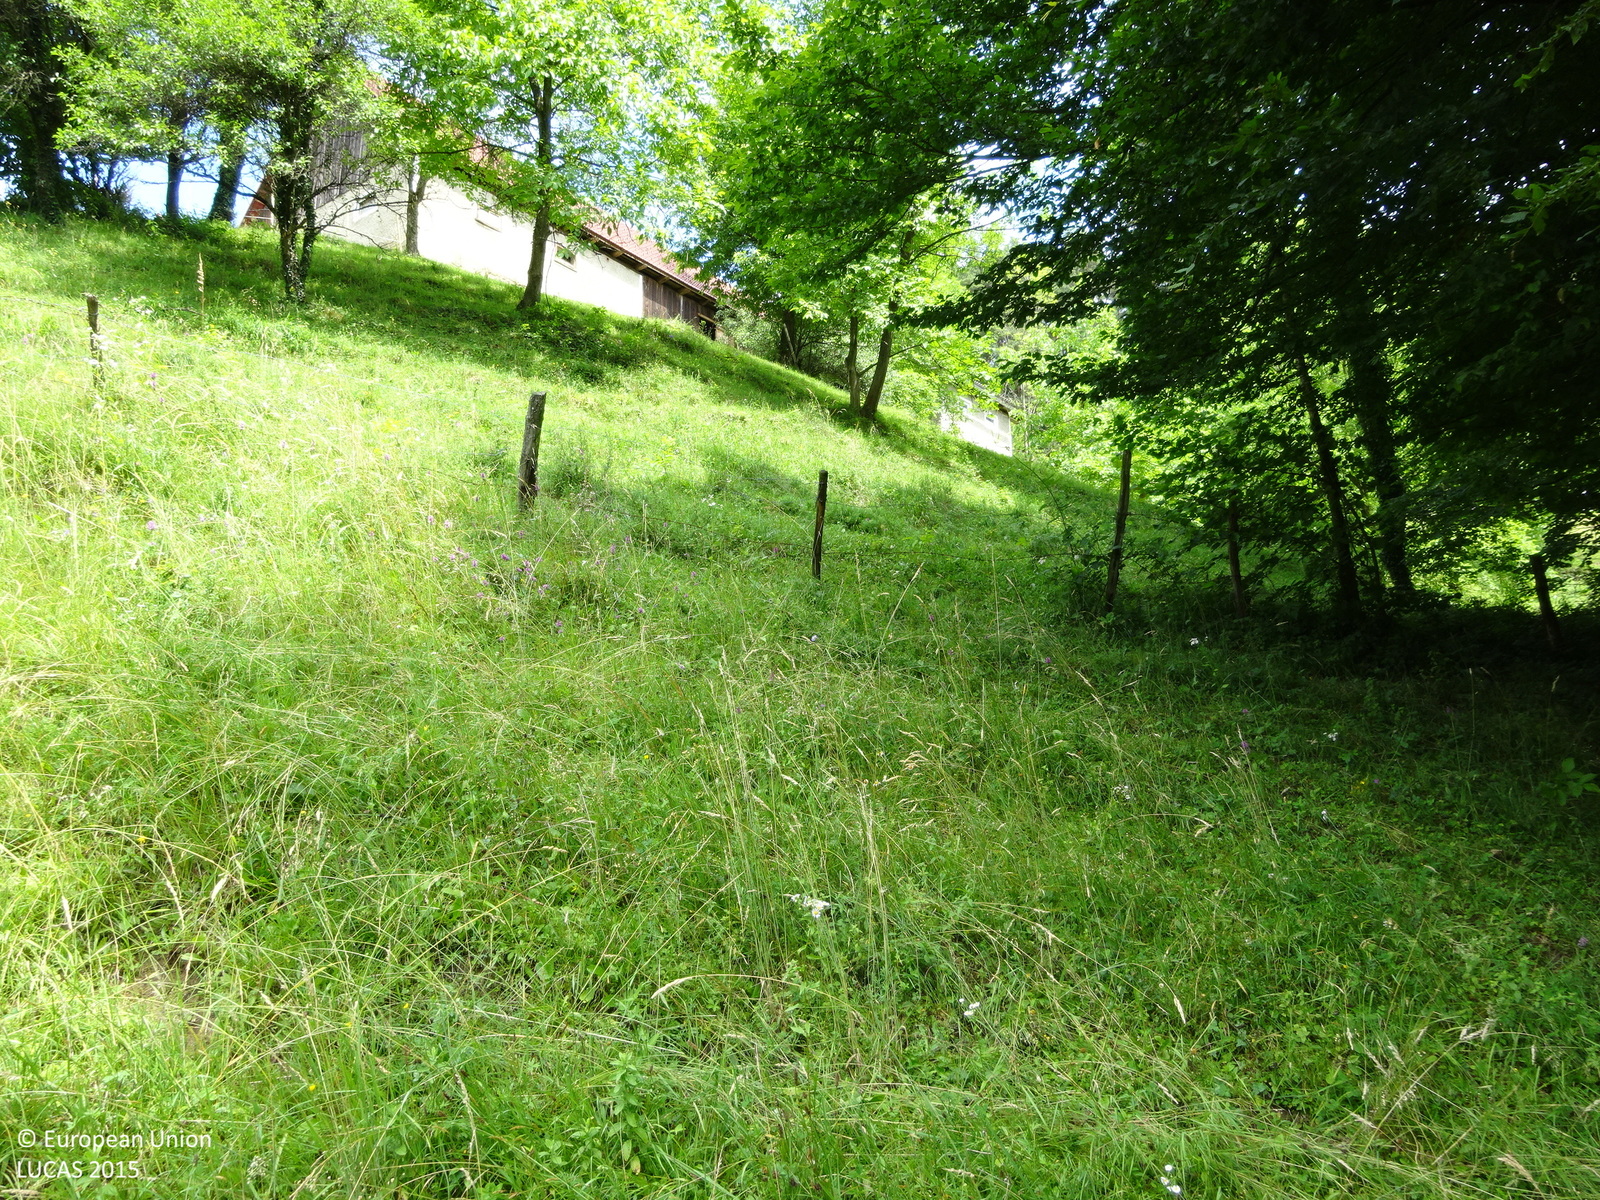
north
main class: Grassland
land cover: Grassland without tree/shrub cover
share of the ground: > 75 %
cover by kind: herbaceous plants 100 %
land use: Agriculture (excluding fallow land and kitchen gardens)
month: June
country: AT
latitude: 46.6815
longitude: 15.4508
